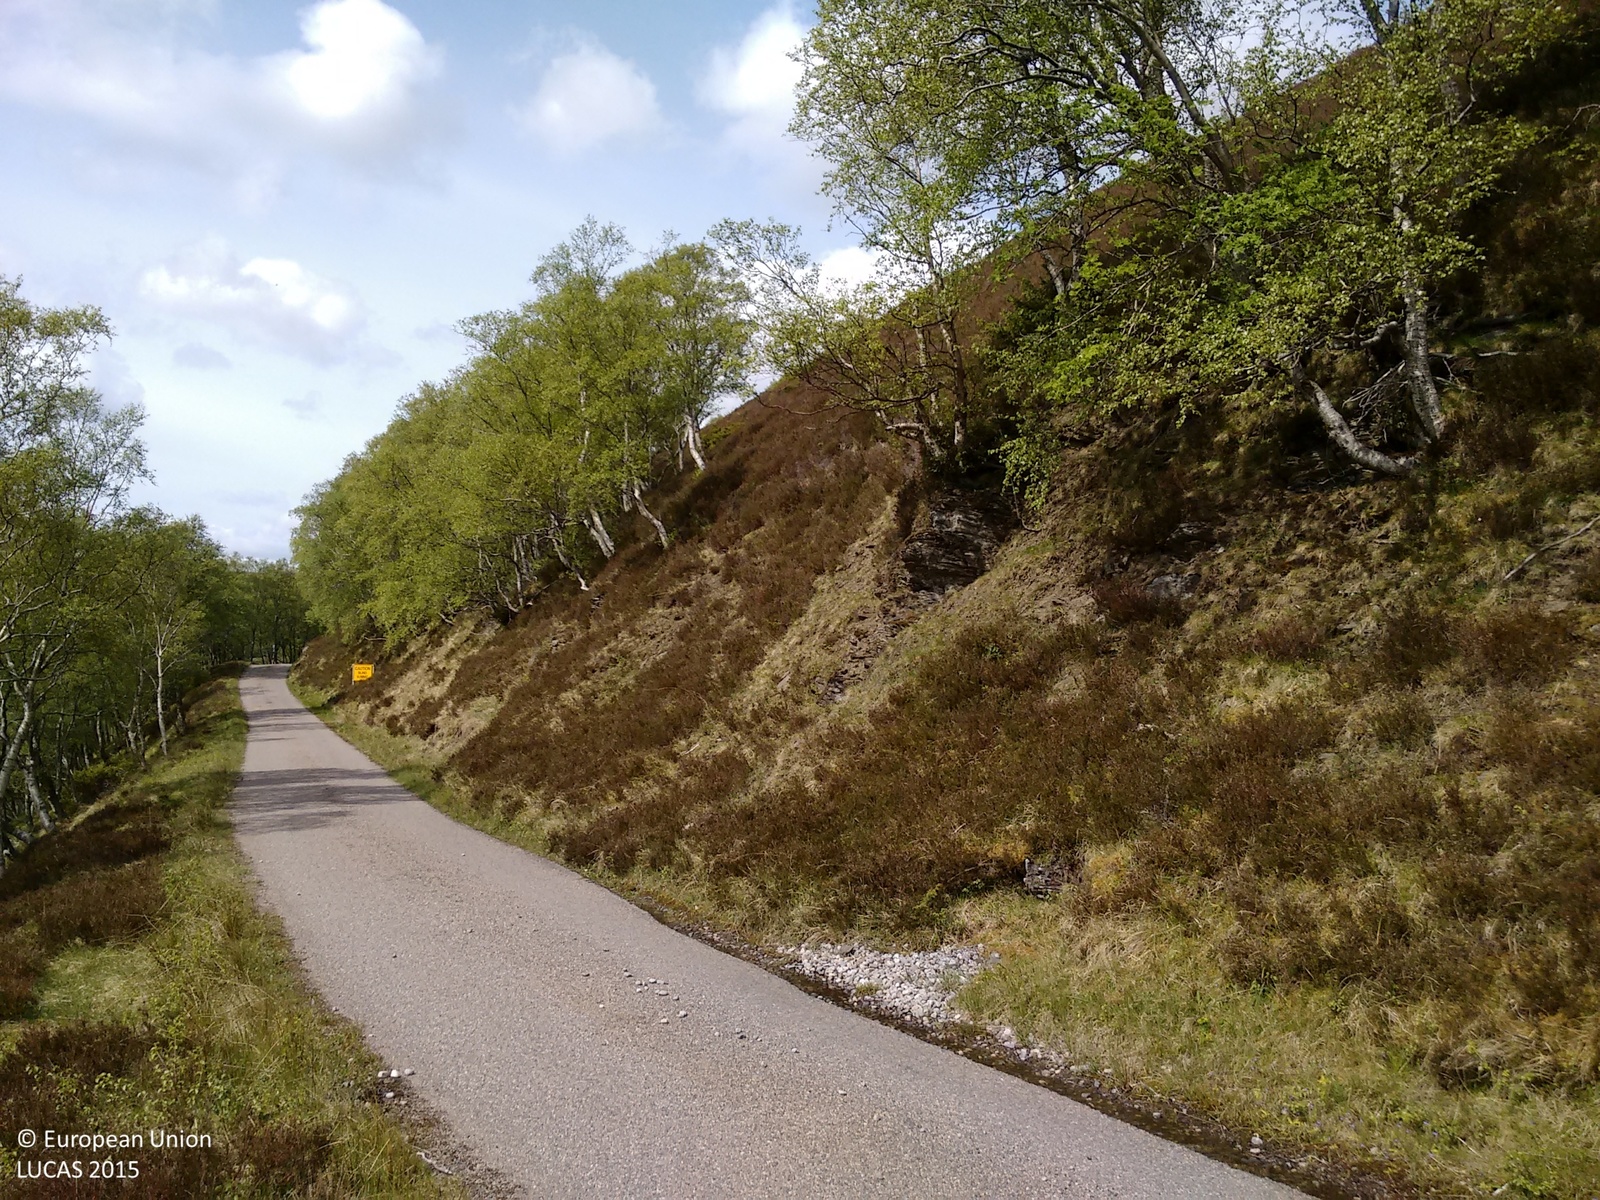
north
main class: Grassland
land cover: Grassland without tree/shrub cover
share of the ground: > 75 %
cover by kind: herbaceous plants 100 %
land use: Agriculture (excluding fallow land and kitchen gardens)
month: June
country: GB
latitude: 57.1979
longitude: -3.3931
